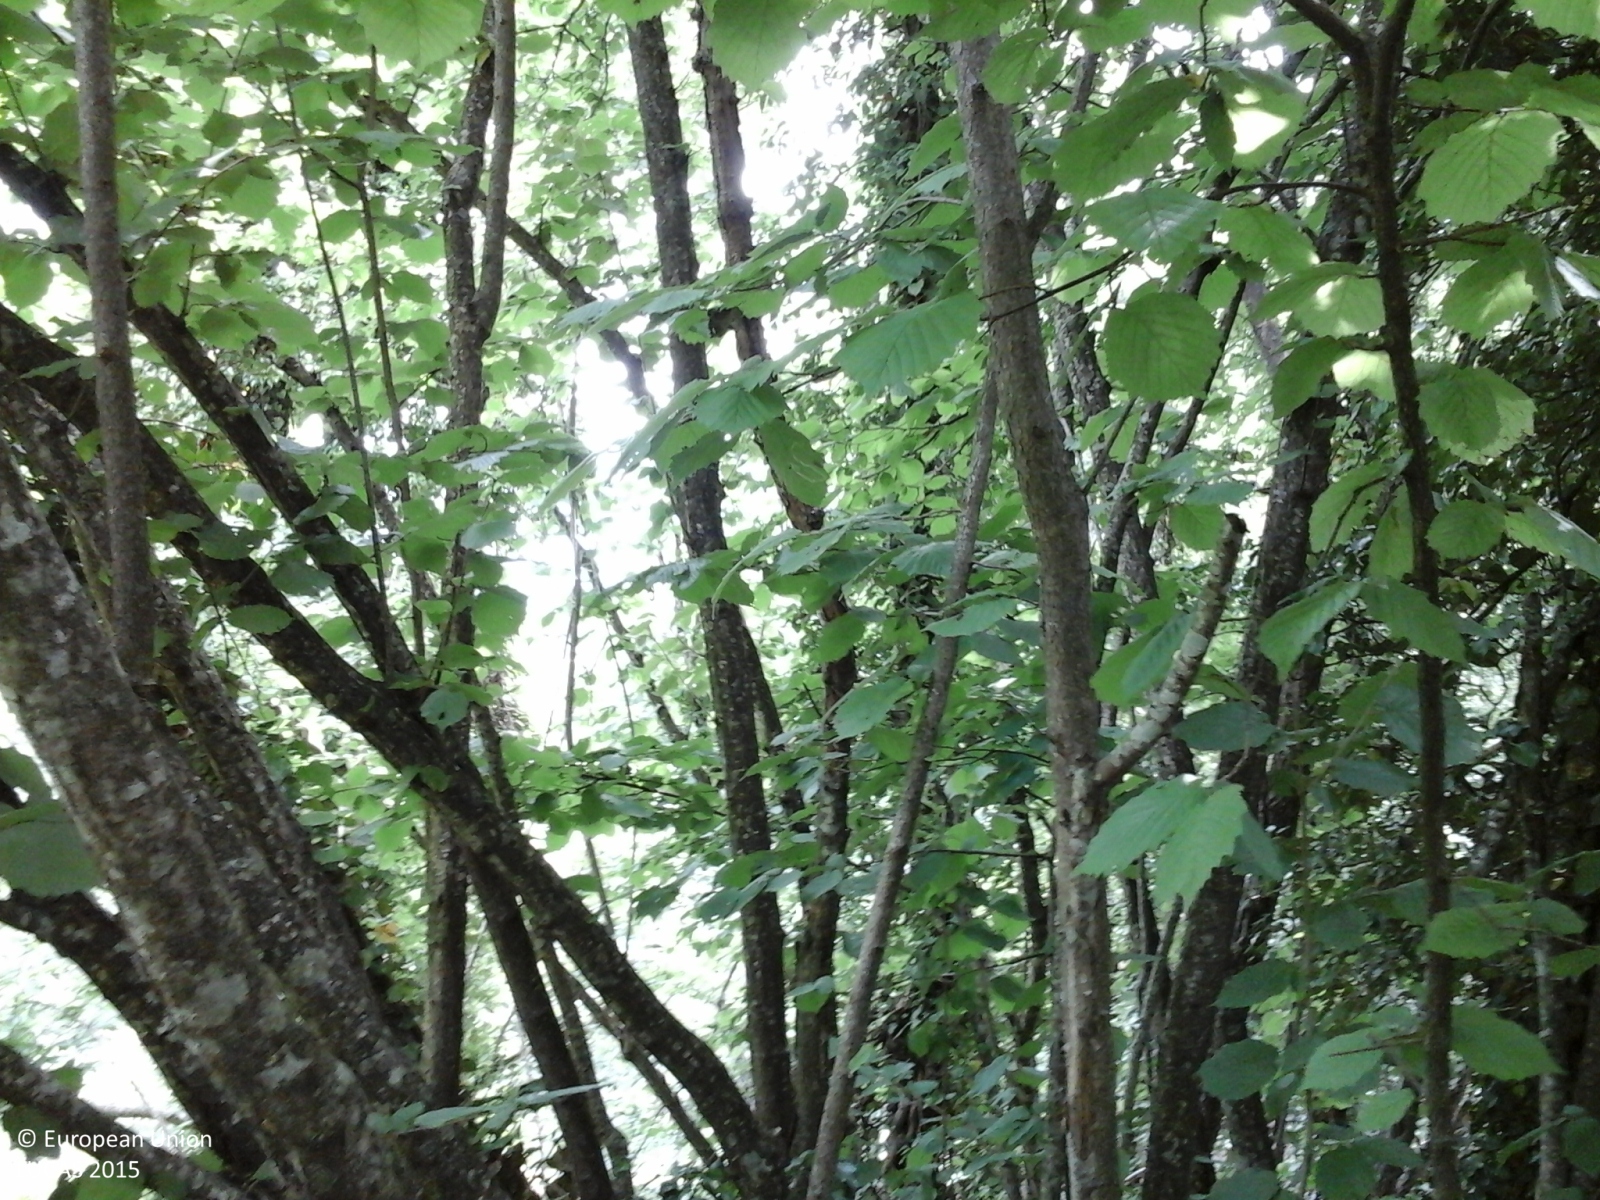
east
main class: Woodland
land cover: Broadleaved woodland
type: thermophilous deciduous forest
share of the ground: > 75 %
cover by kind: broadleaved forest trees 80 %, shrubs 10 %, herbaceous plants 5 %, lichens and mosses 5 %
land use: Forestry
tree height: > 5 m
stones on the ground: > 50 %
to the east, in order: Broadleaved woodland; Grassland with sparse tree/shrub cover; Broadleaved woodland
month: June
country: IT
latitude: 42.0341
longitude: 14.3949
